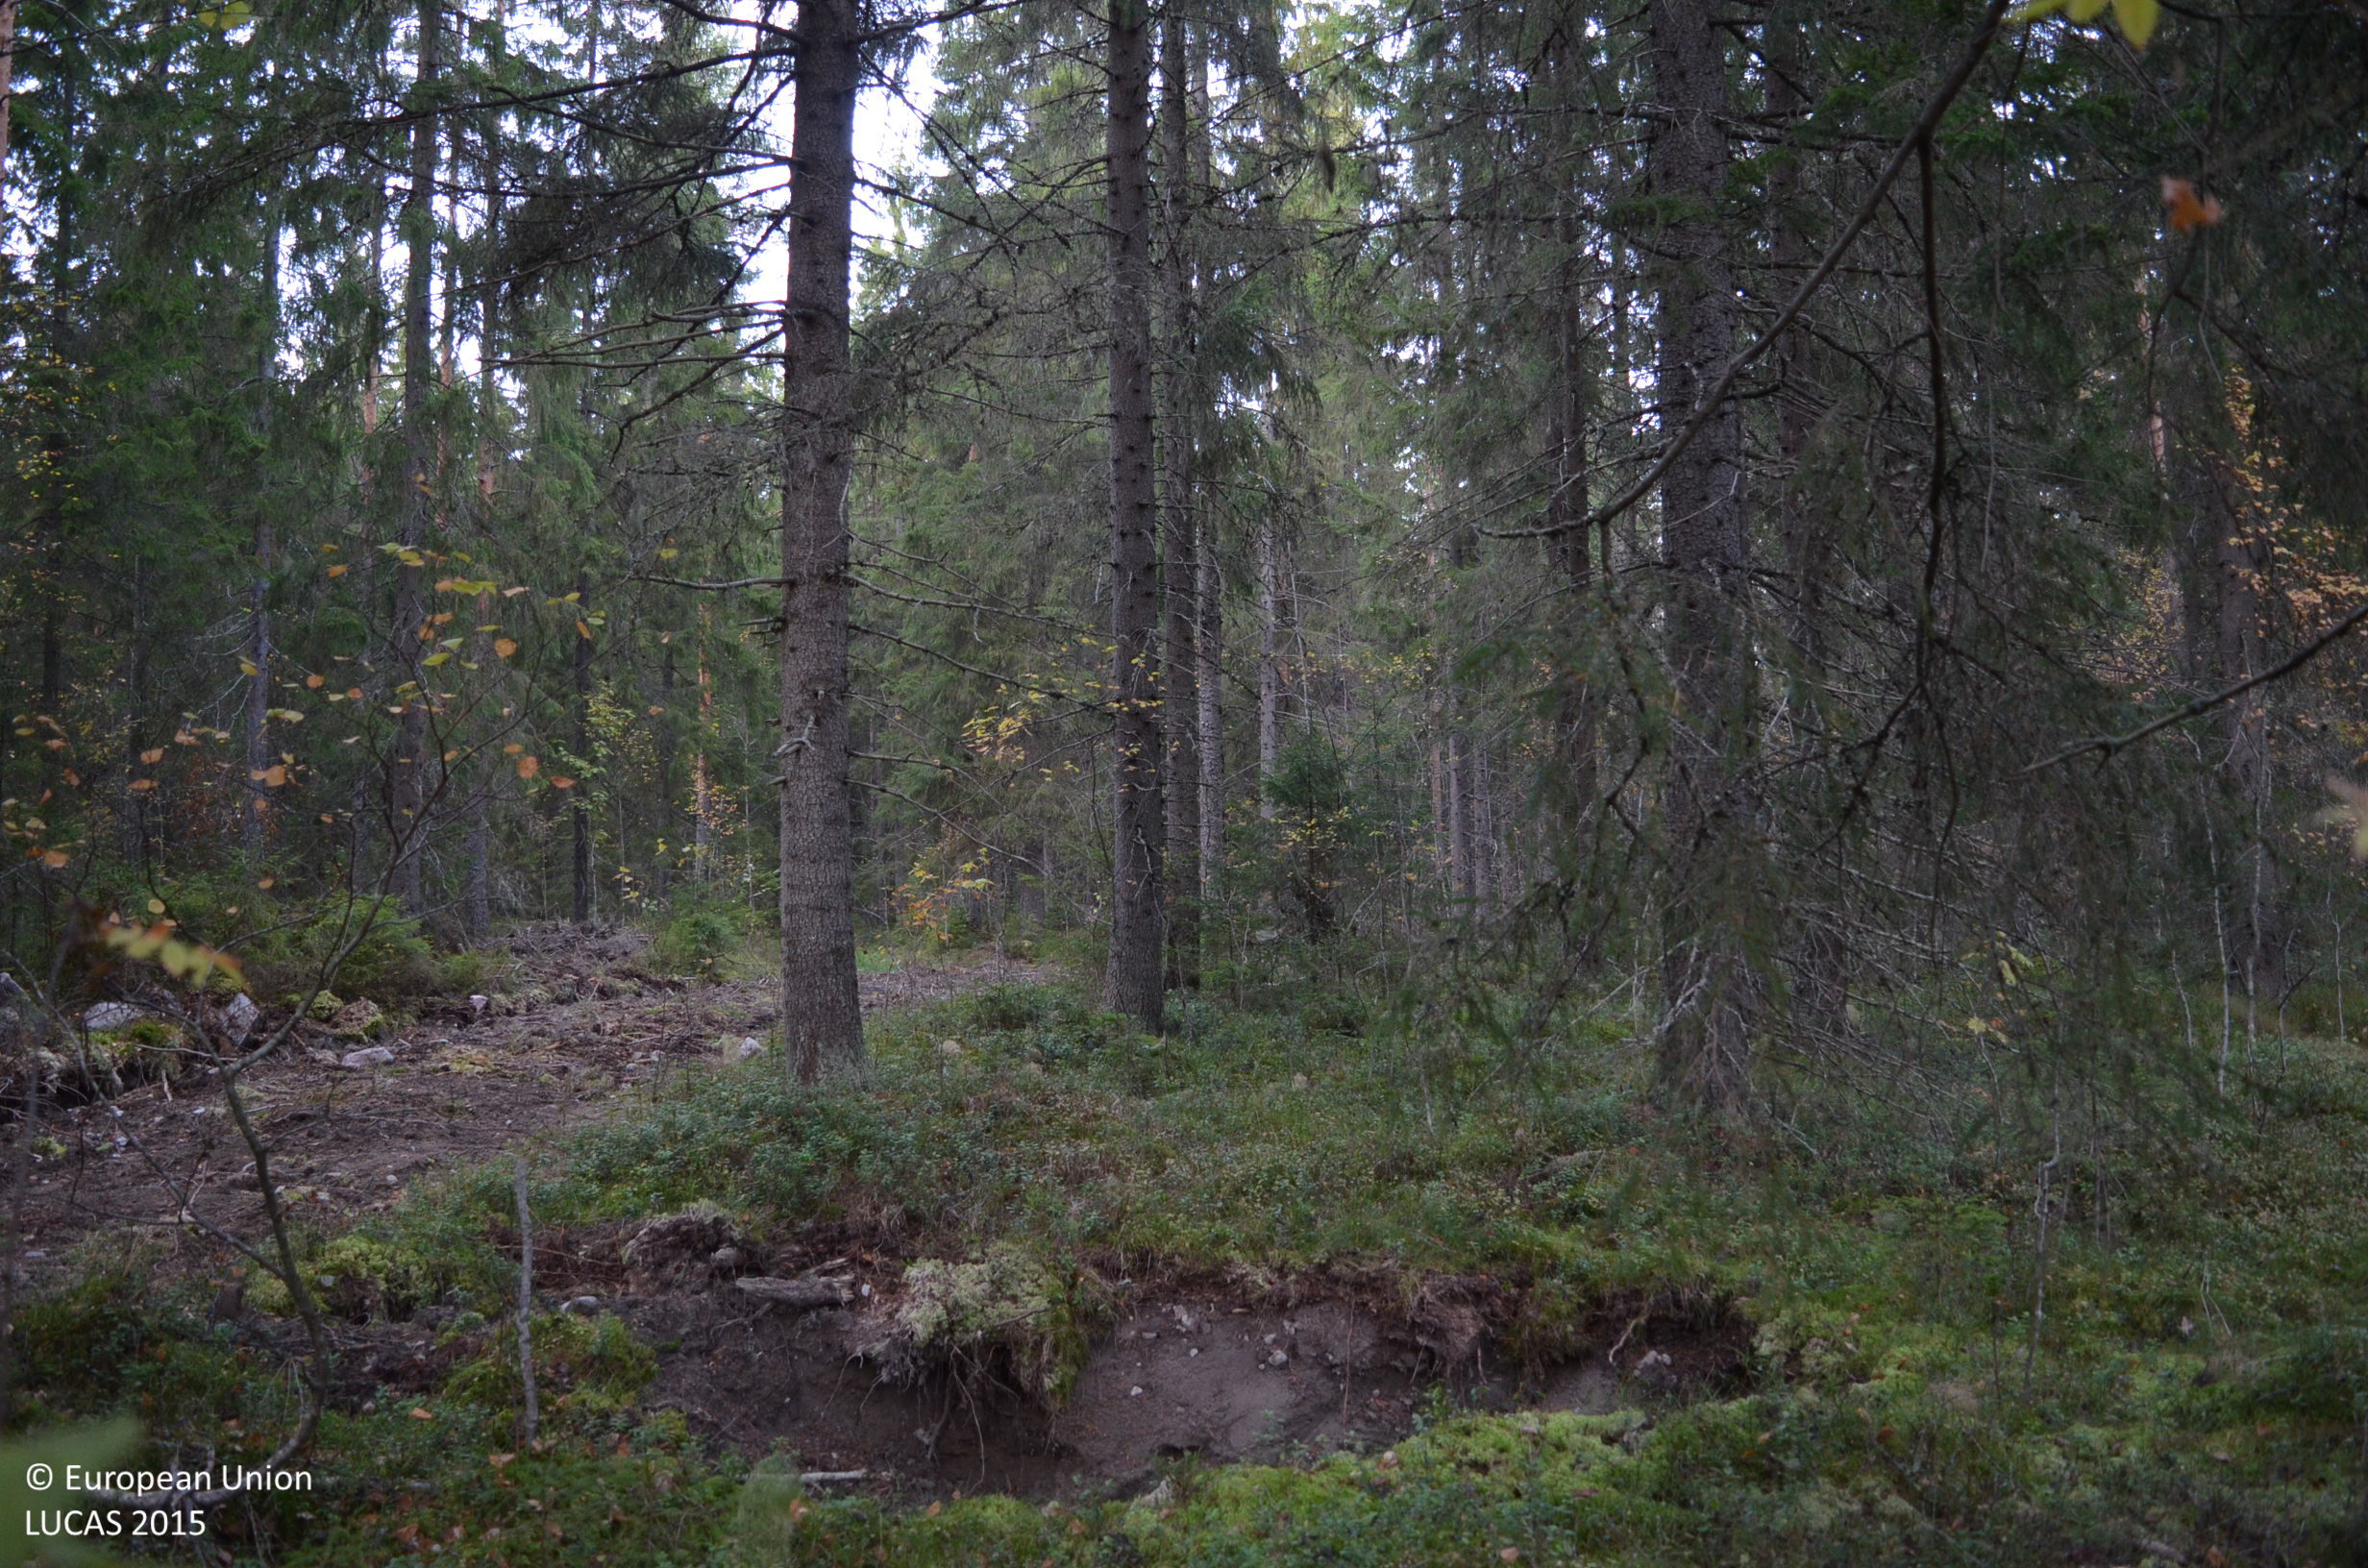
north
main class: Woodland
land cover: Spruce dominated coniferous woodland
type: boreal forest
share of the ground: > 75 %
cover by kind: coniferous forest trees 60 %, shrubs 20 %, broadleaved forest trees 15 %, lichens and mosses 5 %
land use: Forestry
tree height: > 5 m
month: October
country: FI
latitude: 61.7442
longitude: 23.8882
